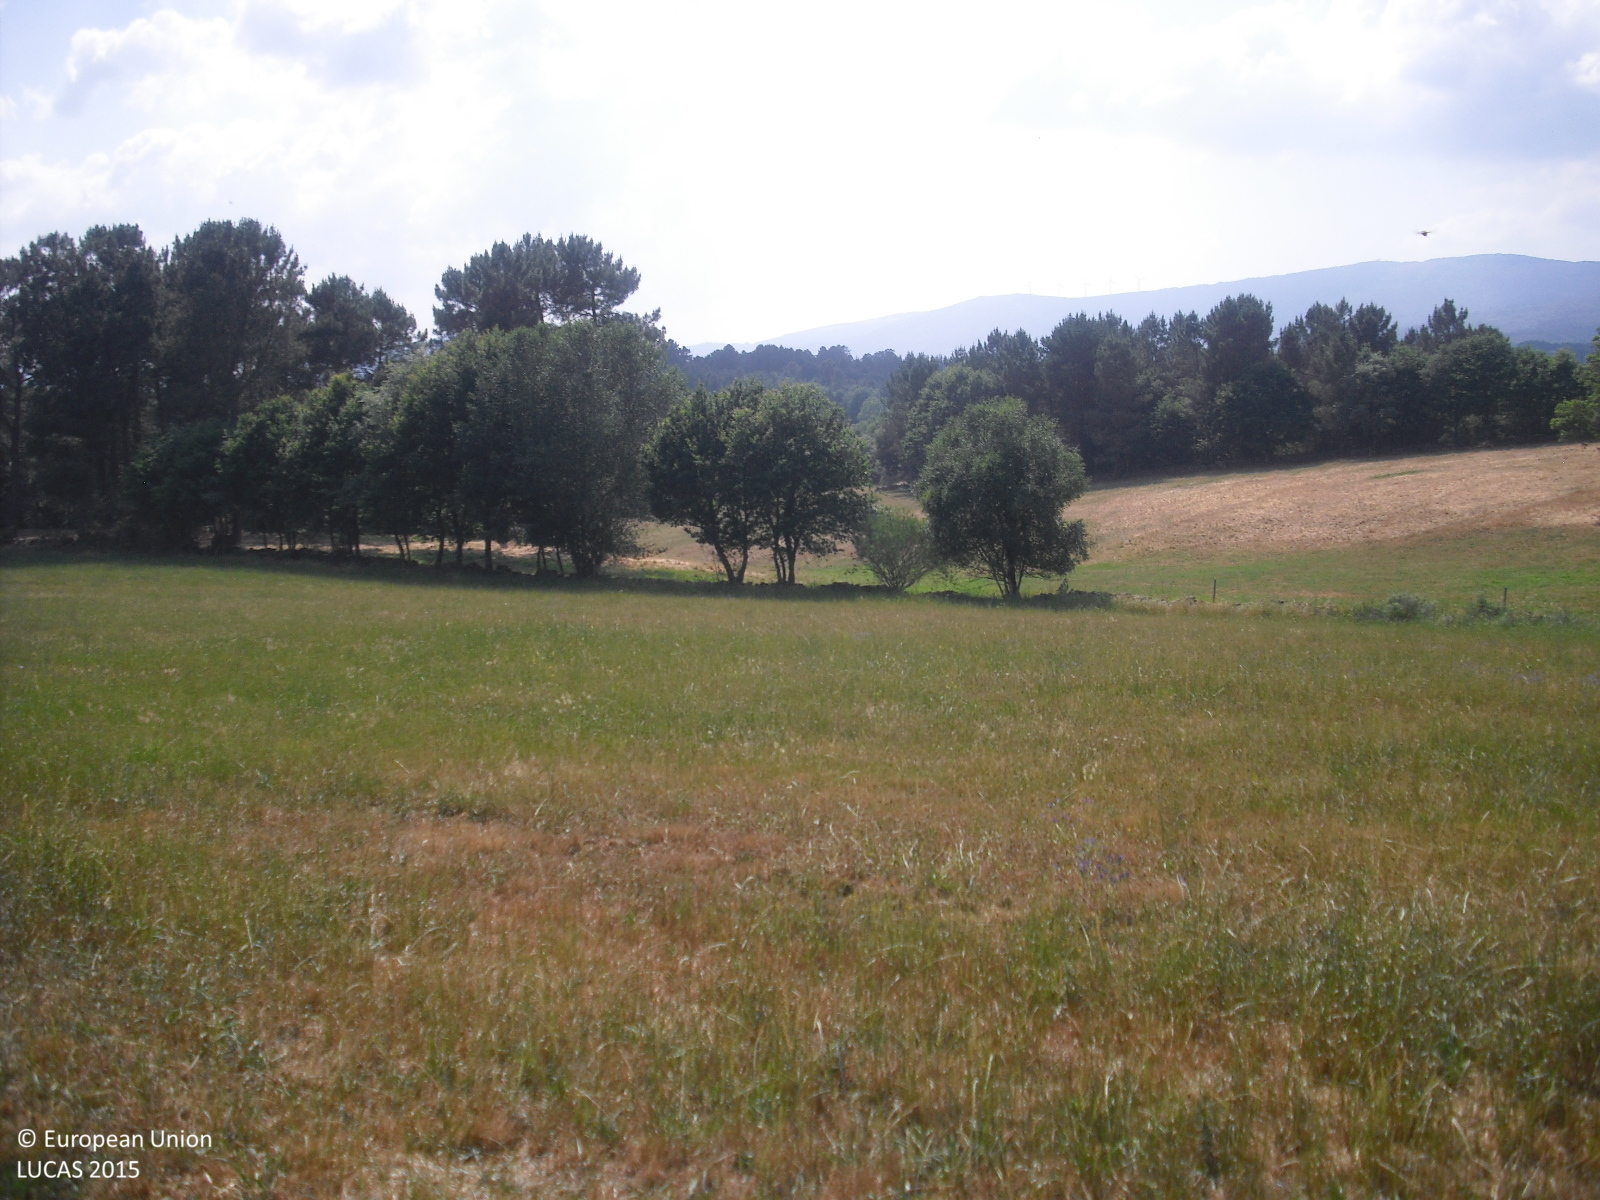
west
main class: Cropland
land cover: Temporary grasslands
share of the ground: > 75 %
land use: Agriculture (excluding fallow land and kitchen gardens)
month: June
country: ES
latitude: 42.6091
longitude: -7.8154
